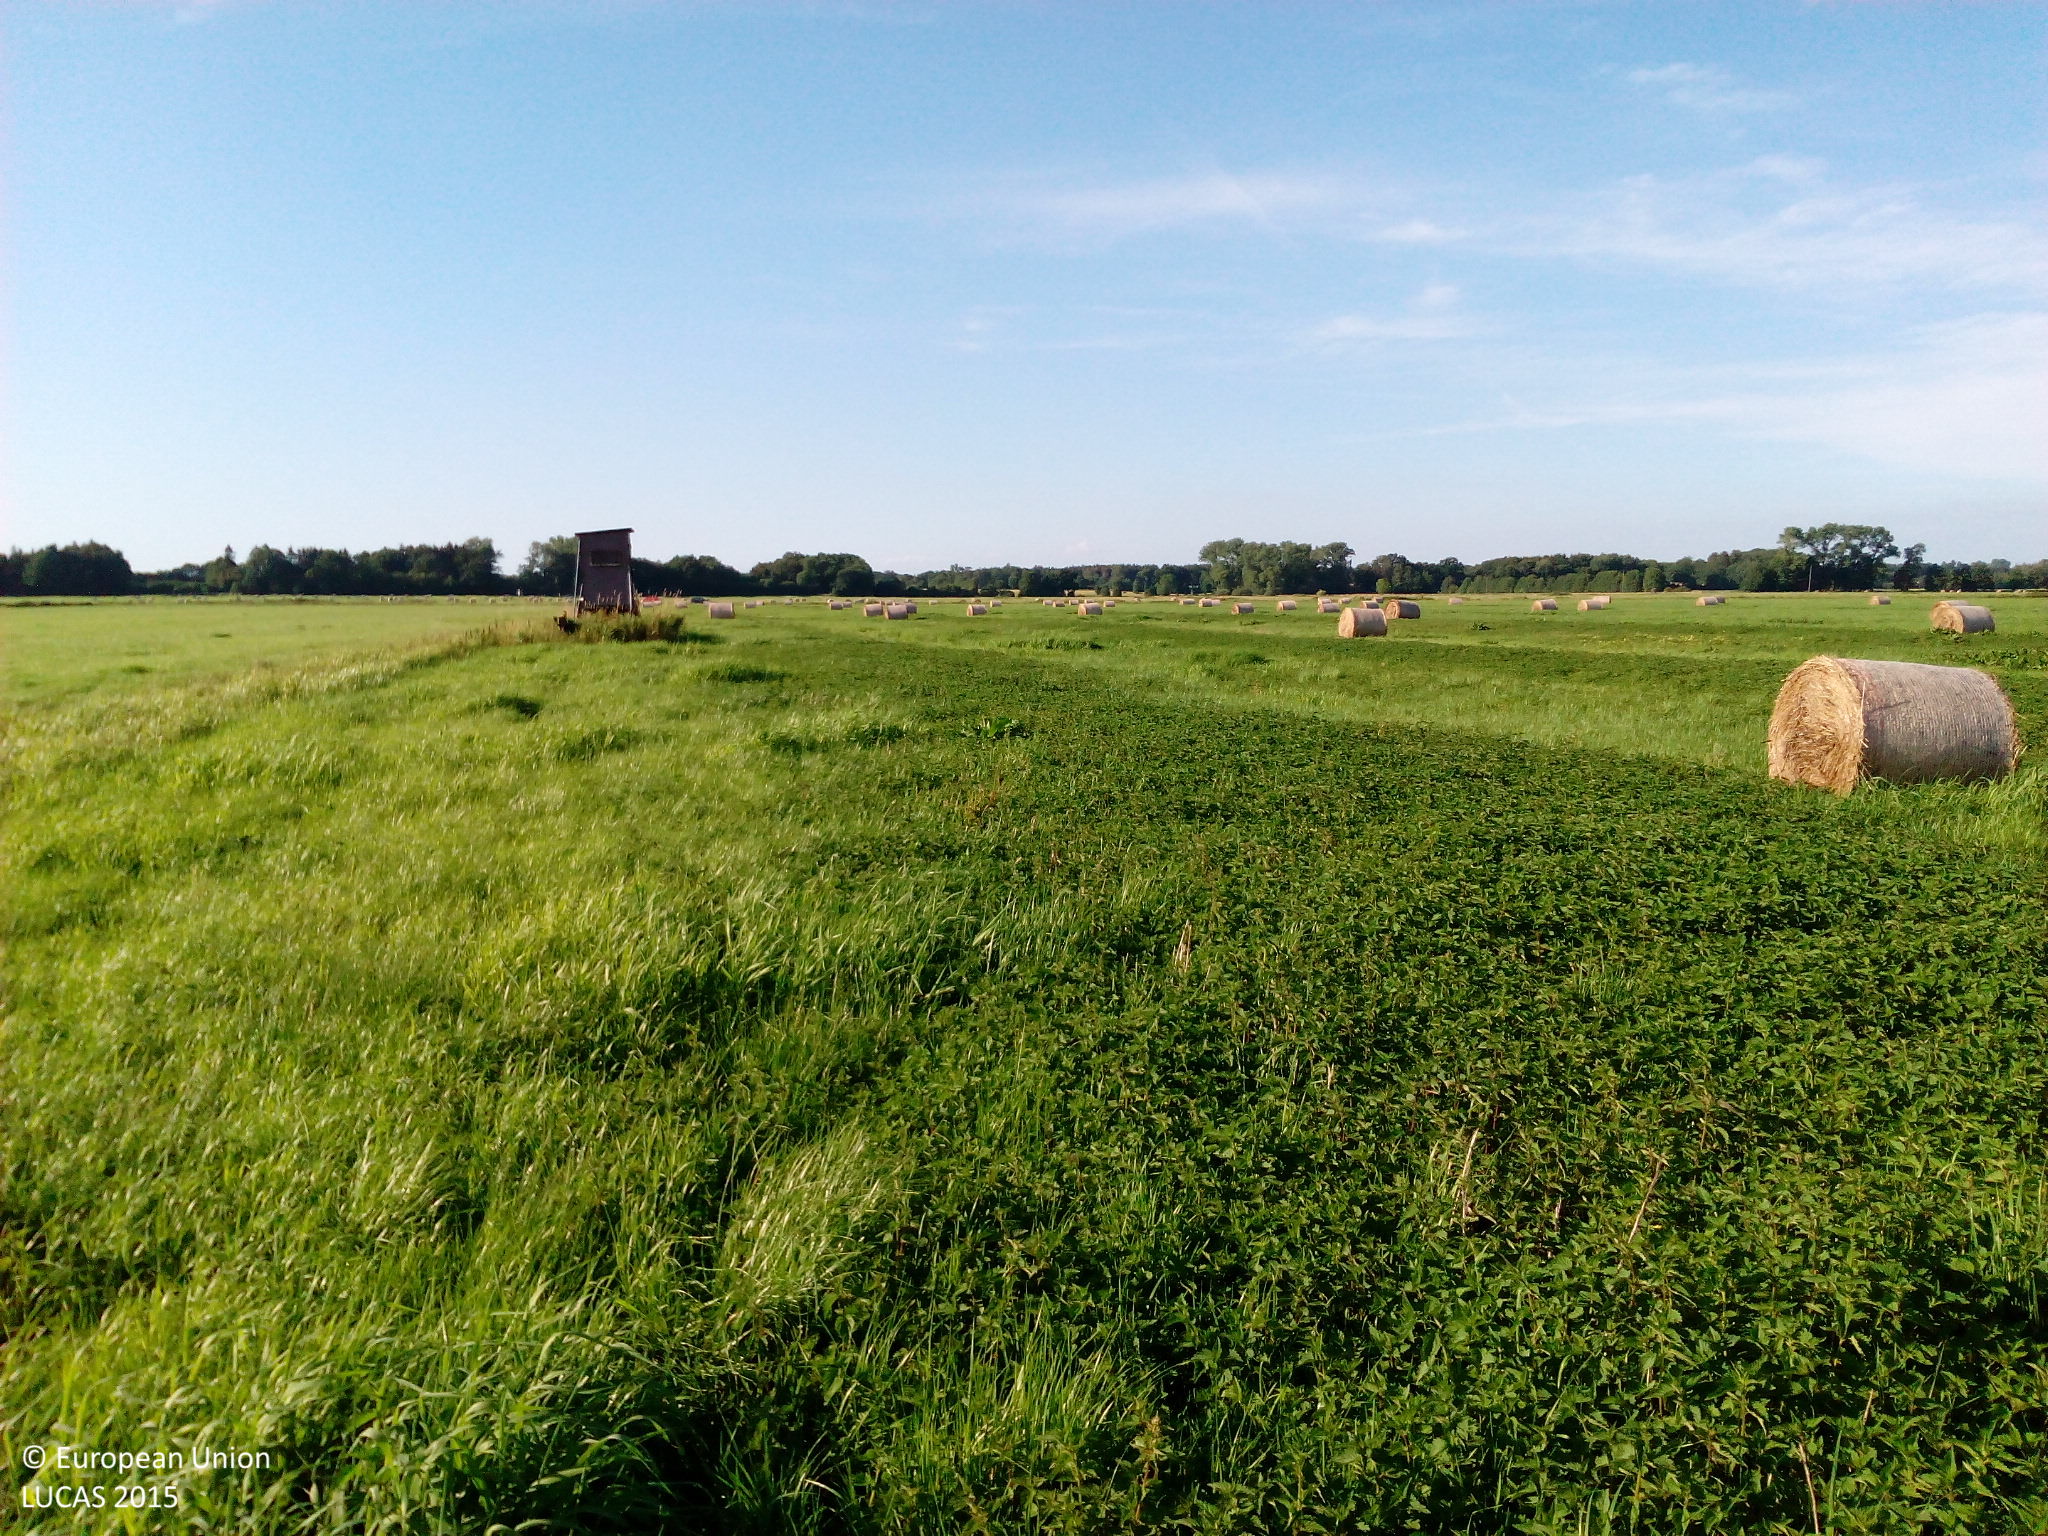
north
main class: Grassland
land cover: Grassland without tree/shrub cover
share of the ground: > 75 %
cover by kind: herbaceous plants 100 %
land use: Agriculture (excluding fallow land and kitchen gardens)
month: August
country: DE
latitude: 53.9406
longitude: 9.6498
